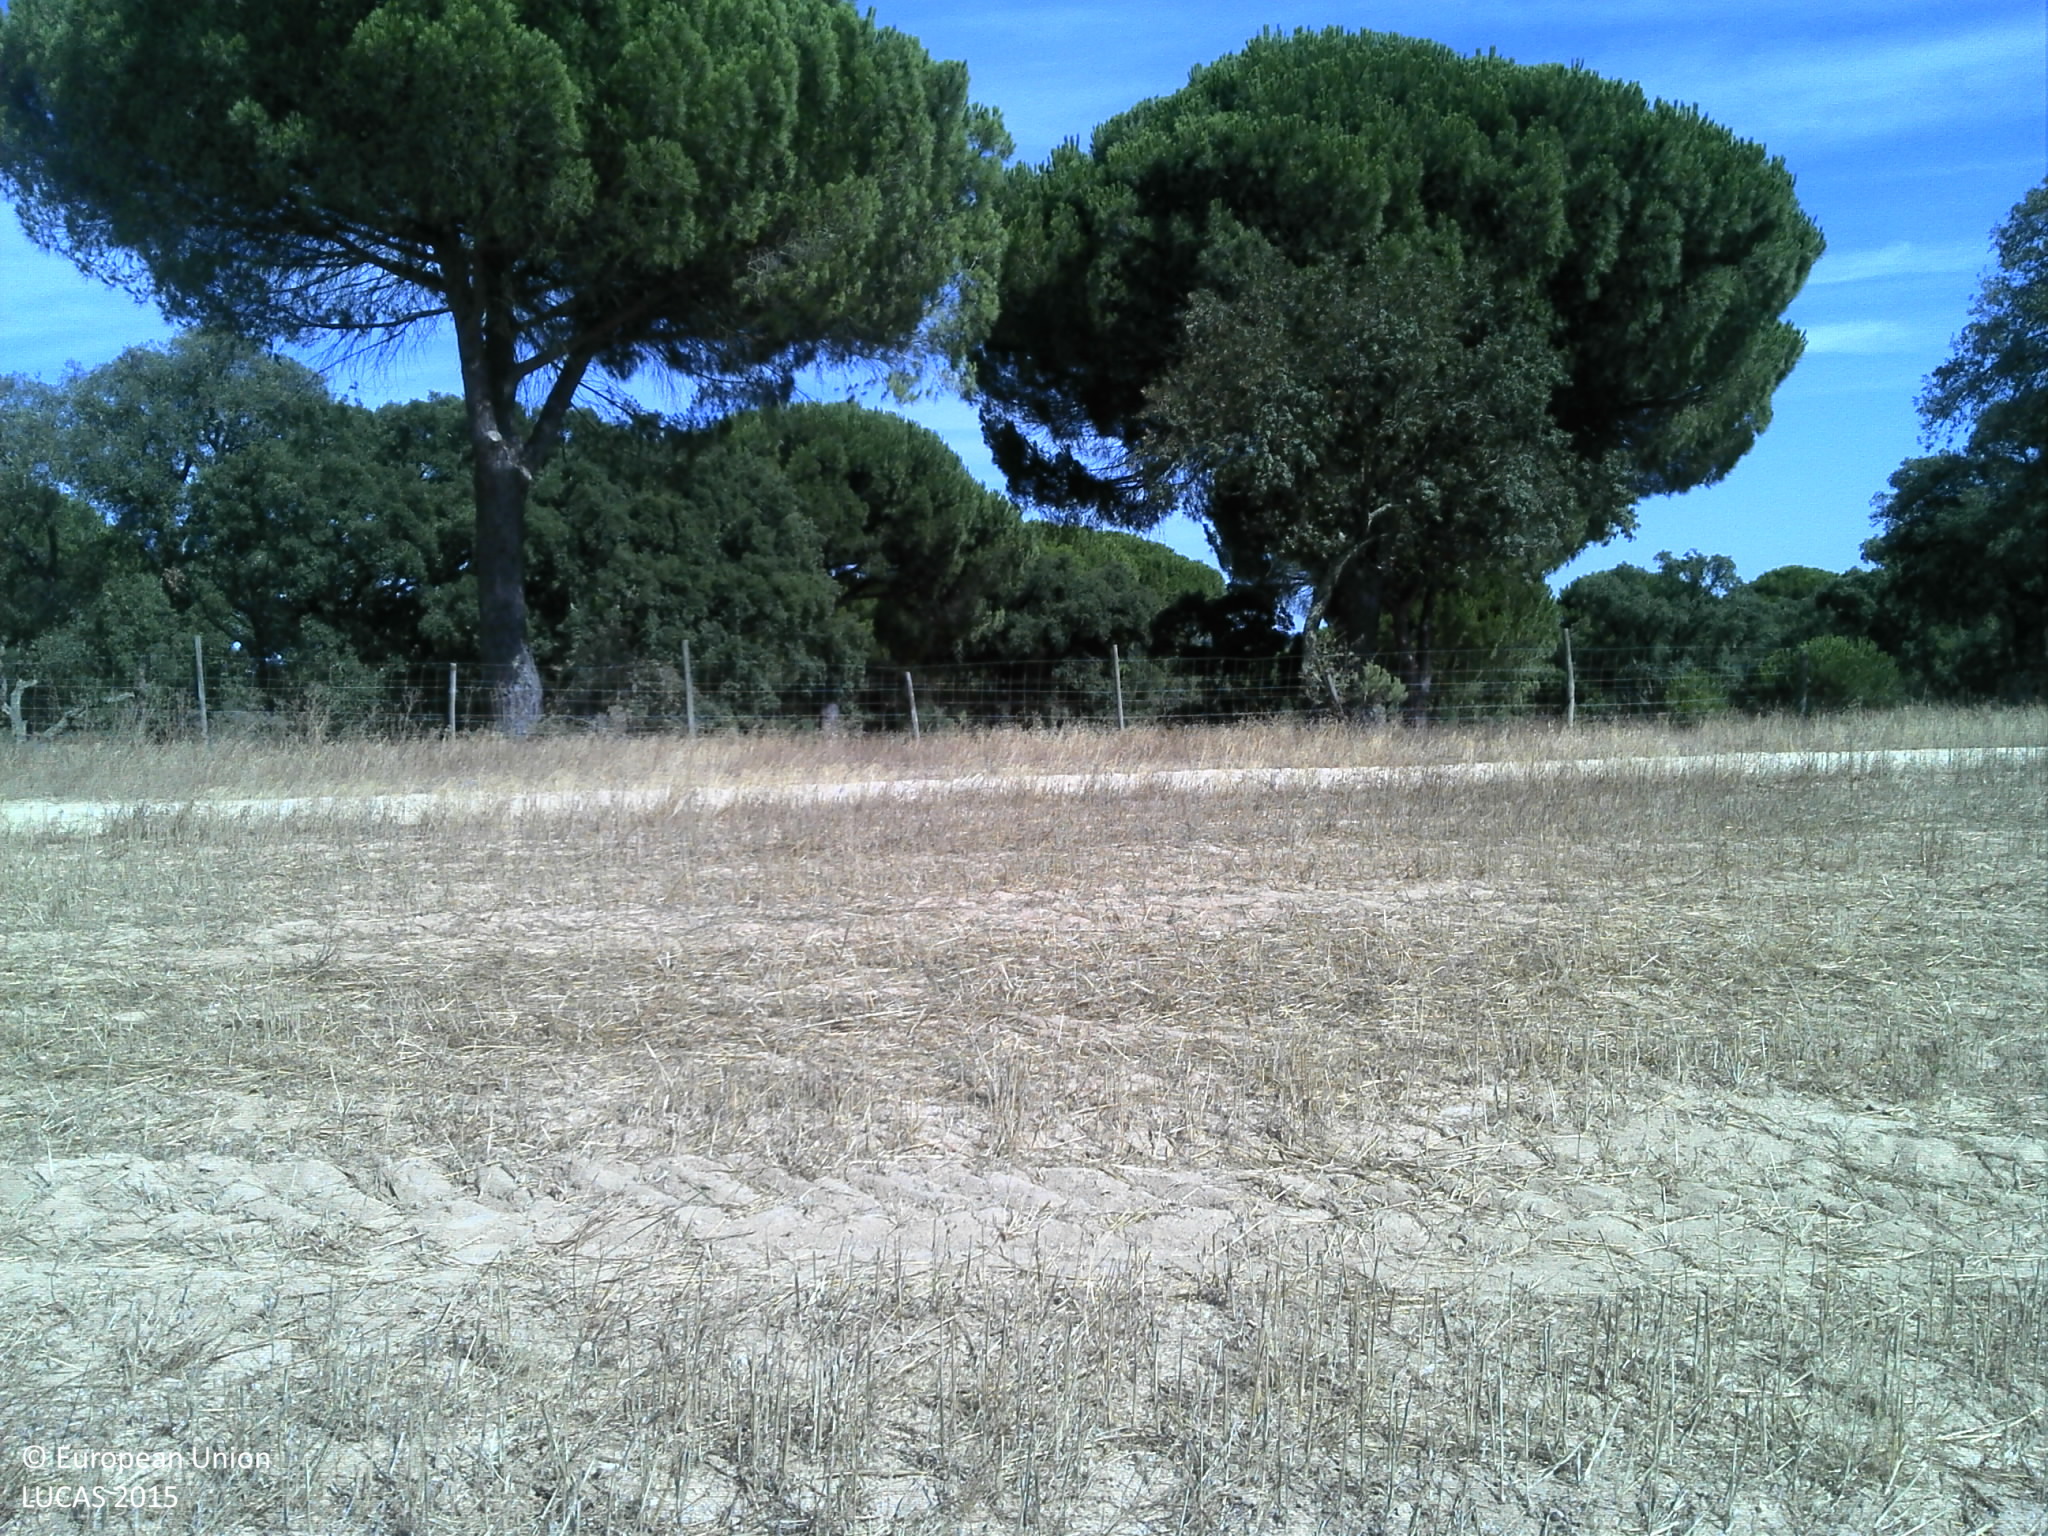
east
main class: Cropland
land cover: Common wheat
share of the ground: < 10 %
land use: Agriculture (excluding fallow land and kitchen gardens)
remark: Harvested field
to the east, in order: Common wheat; Tracks; Other bare soil; Grass margins; Fences; Pine dominated coniferous woodland; Broadleaved woodland
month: August
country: PT
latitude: 38.7229
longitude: -8.5422
